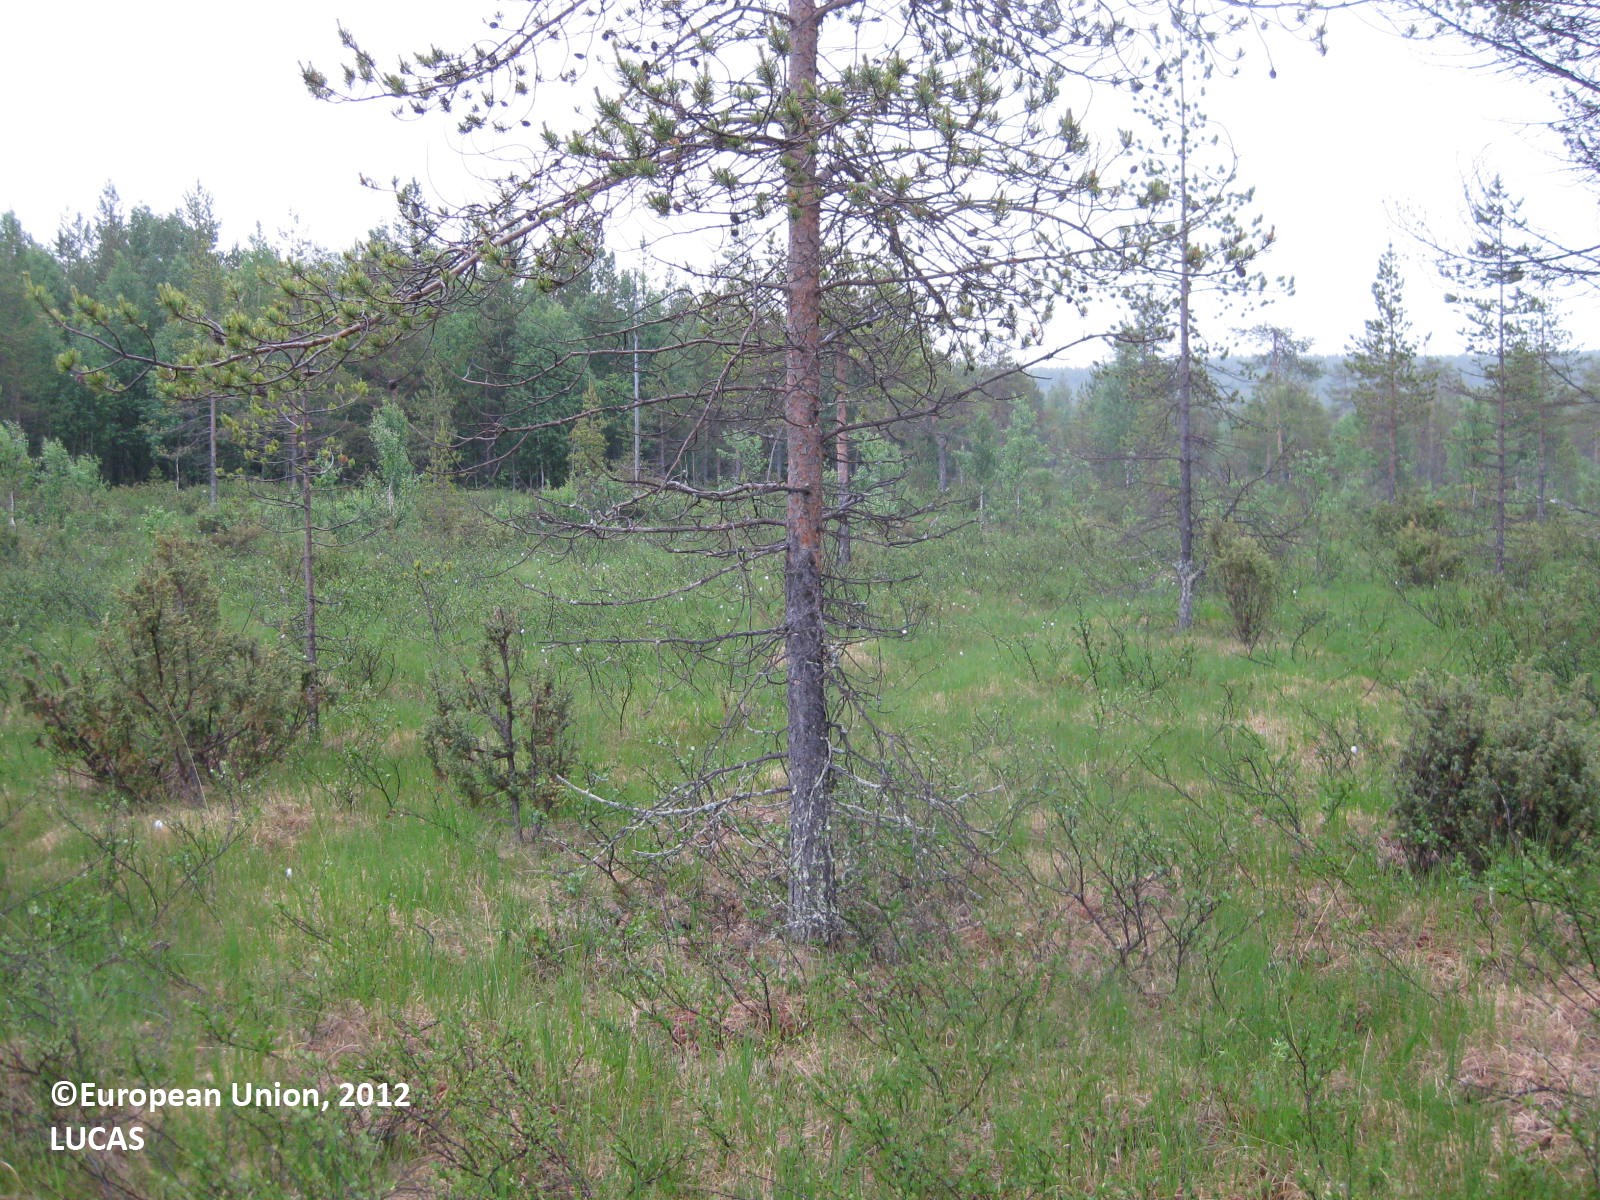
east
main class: Woodland
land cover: Pine dominated coniferous woodland
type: boreal forest
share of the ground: 25 - 50 %
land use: Forestry
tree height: > 5 m
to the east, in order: Pine dominated coniferous woodland; Broadleaved woodland; Ditches and canals; Pine dominated mixed woodland; Ditches and canals; Pine dominated mixed woodland; Ditches and canals; Pine dominated mixed woodland; Ditches and canals; Pine dominated mixed woodland; Ditches and canals; Pine dominated mixed woodland; Ditches and canals; Pine dominated mixed woodland
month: July
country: FI
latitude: 65.6479
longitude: 29.4733
